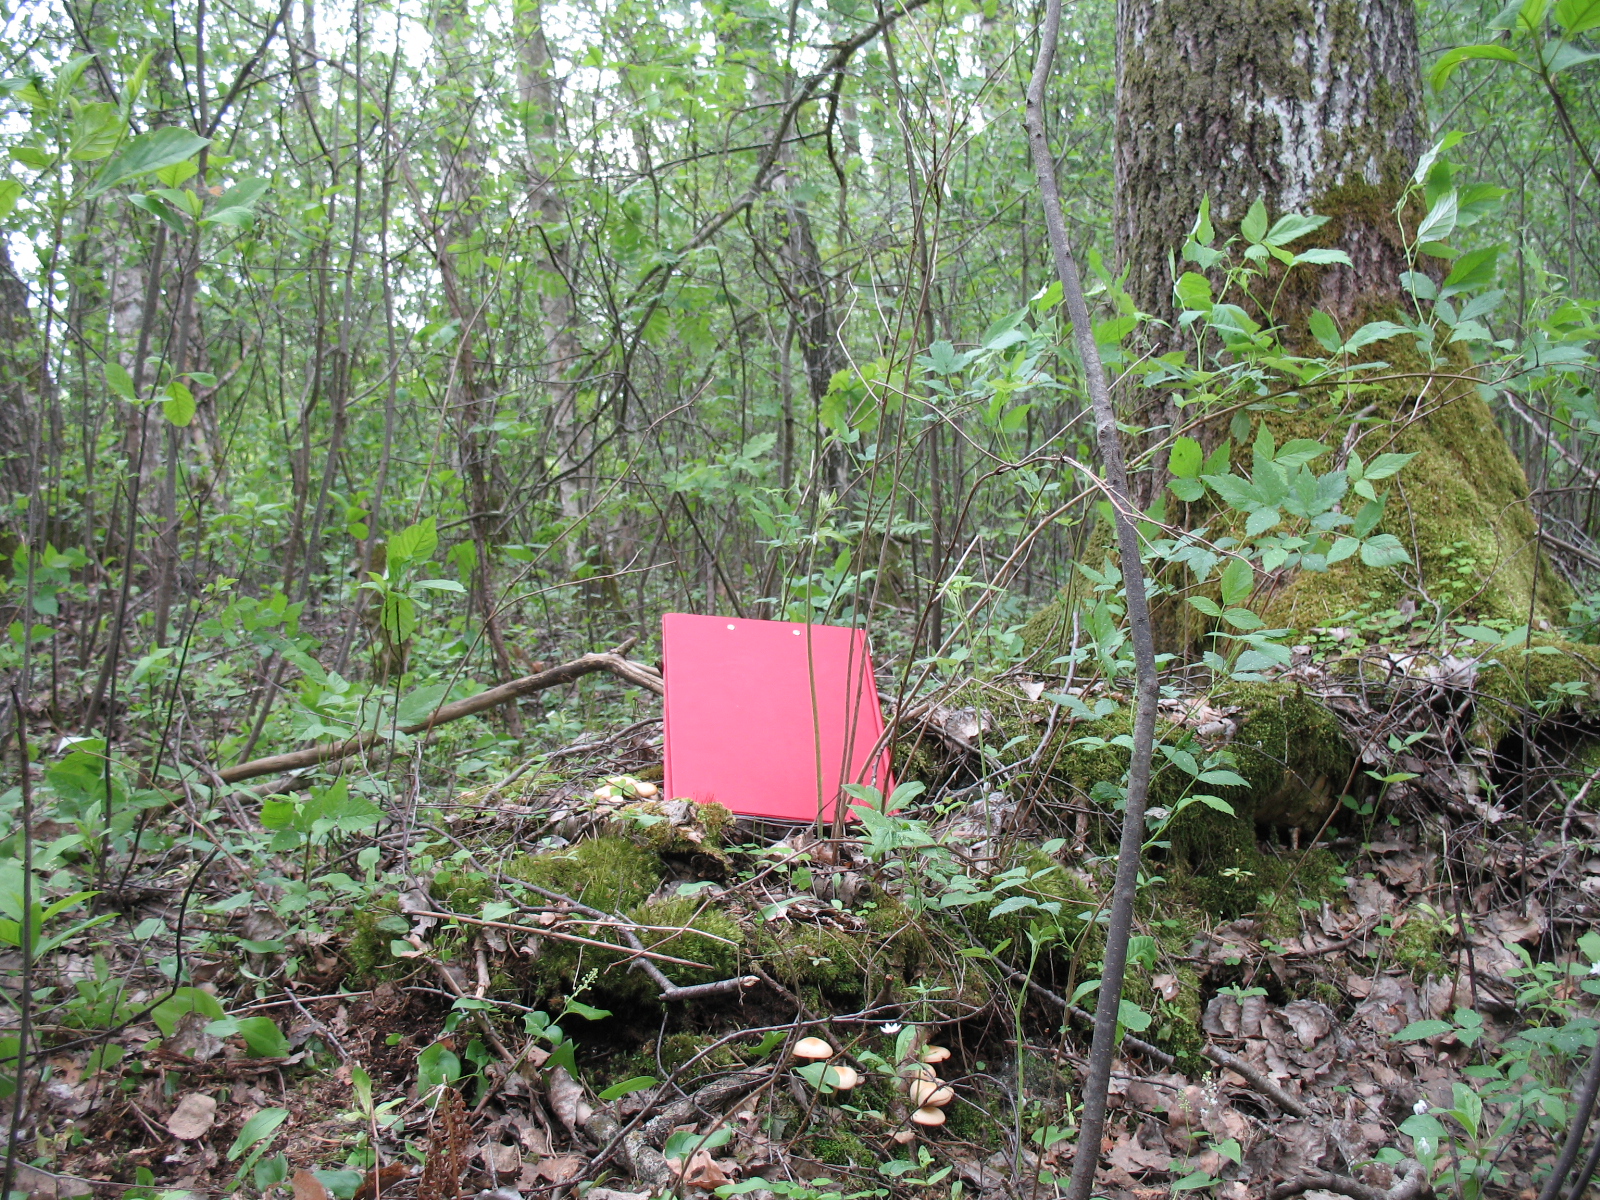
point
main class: Woodland
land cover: Broadleaved woodland
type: non-riverine alder, birch or aspen forest
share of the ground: > 75 %
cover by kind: broadleaved forest trees 95 %, shrubs 5 %
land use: Forestry
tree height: > 5 m
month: May
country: LV
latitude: 56.7803
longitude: 23.5442
